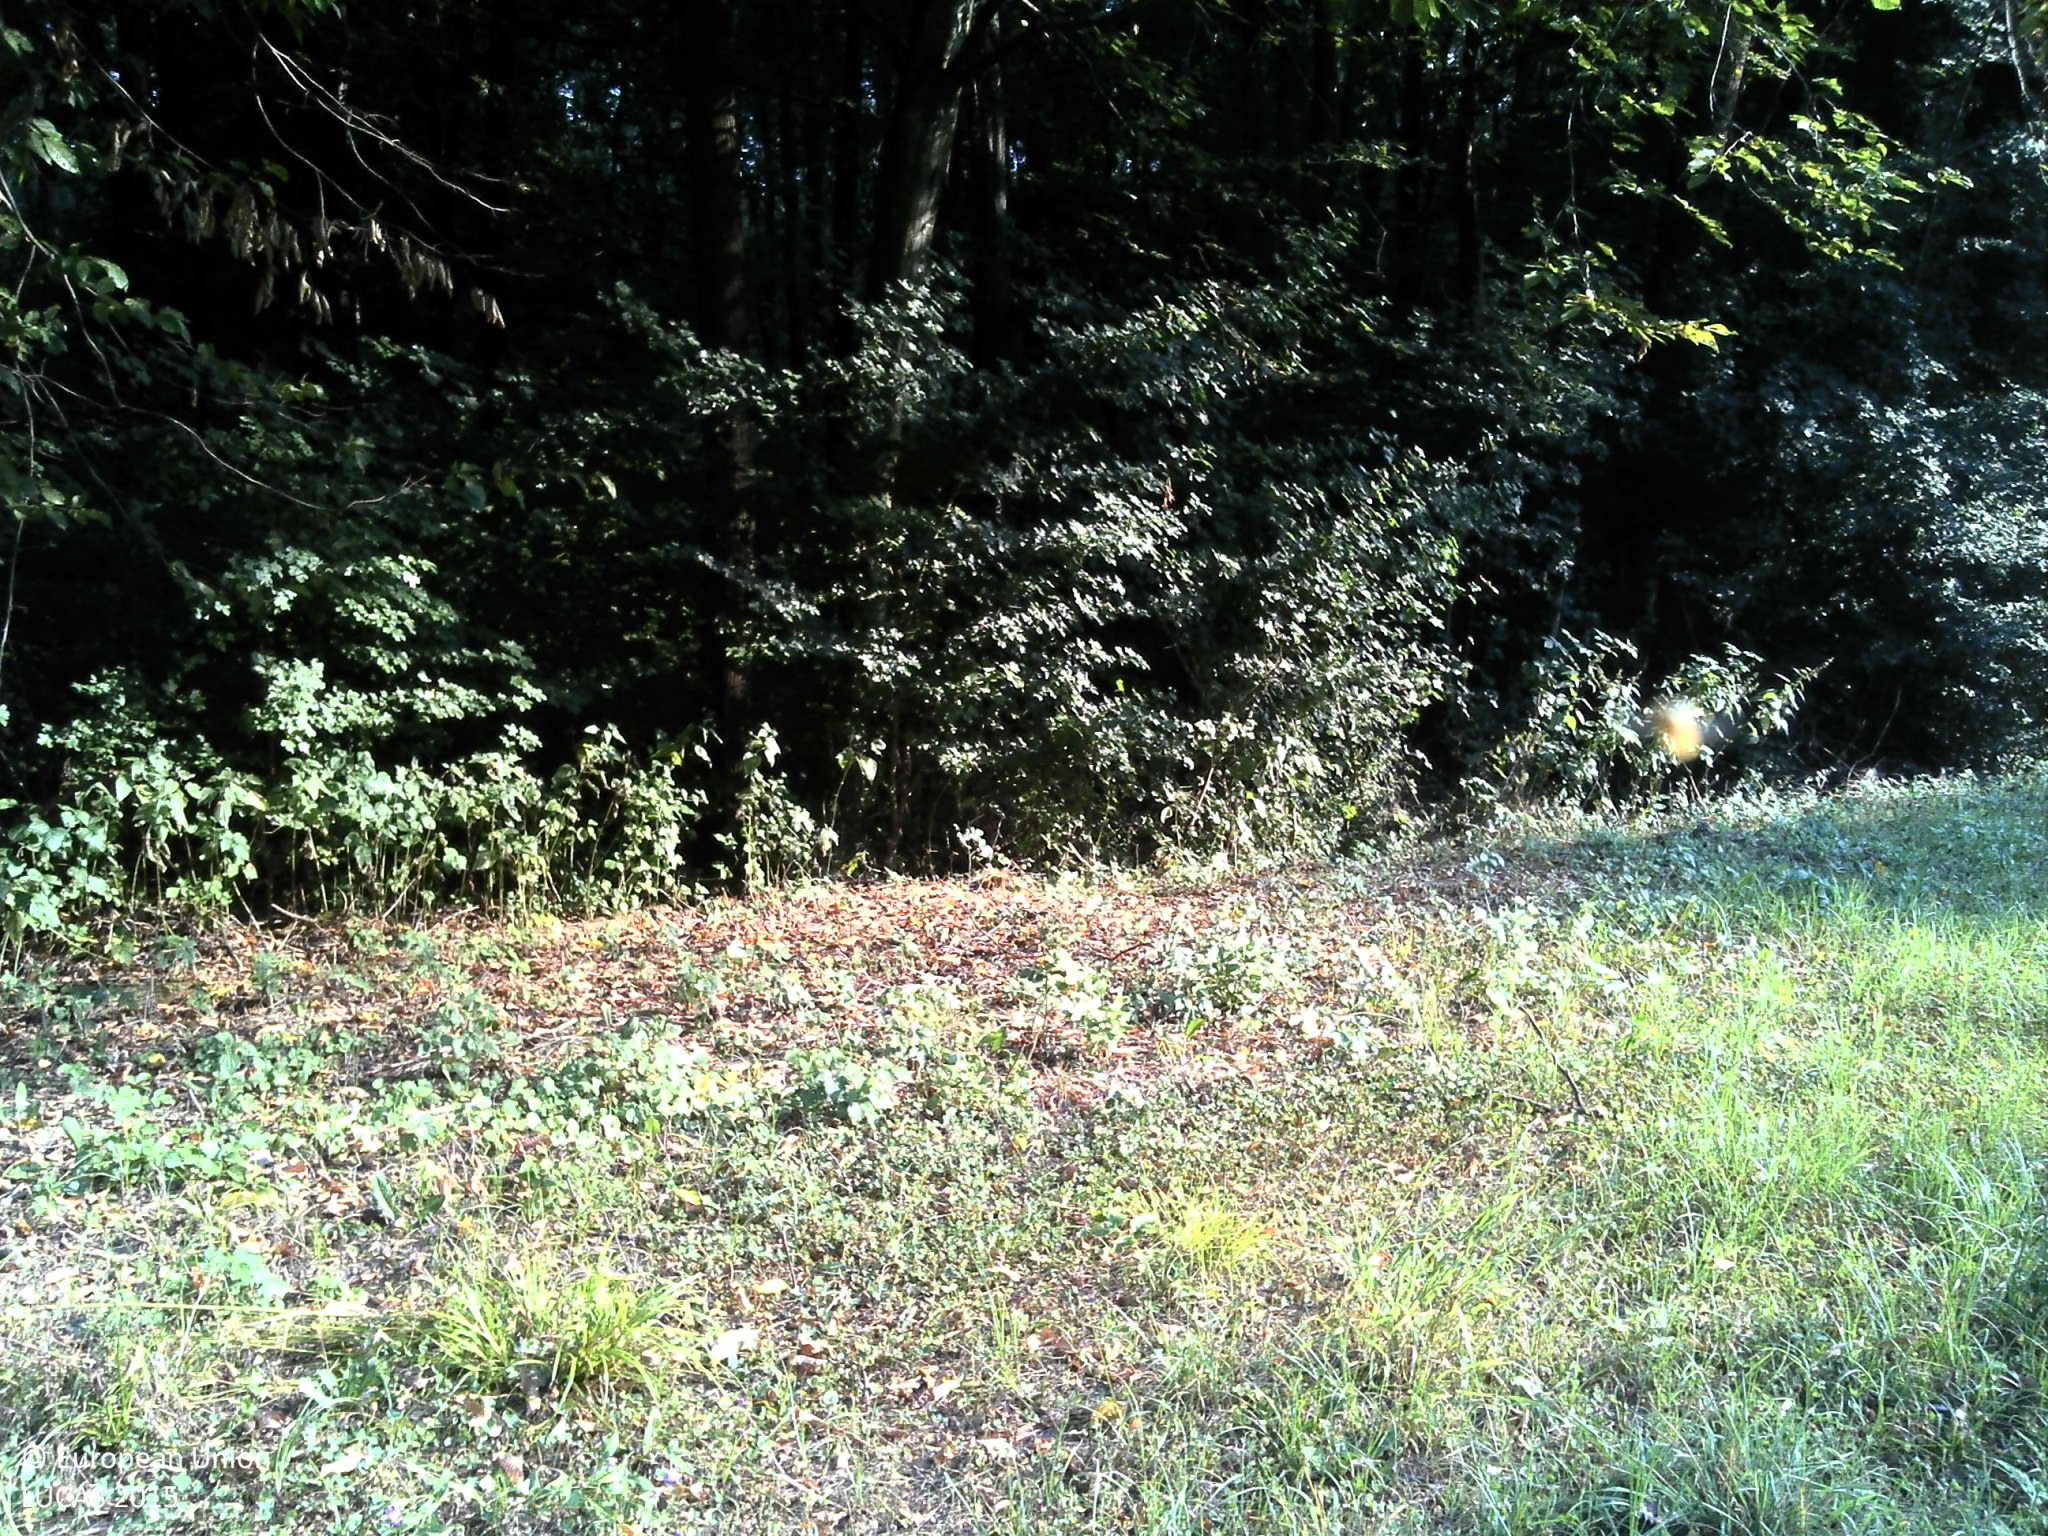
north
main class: Grassland
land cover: Spontaneously vegetated surfaces
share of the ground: > 75 %
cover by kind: herbaceous plants 100 %
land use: Road transport
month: August
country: HR
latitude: 45.9575
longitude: 17.2922
